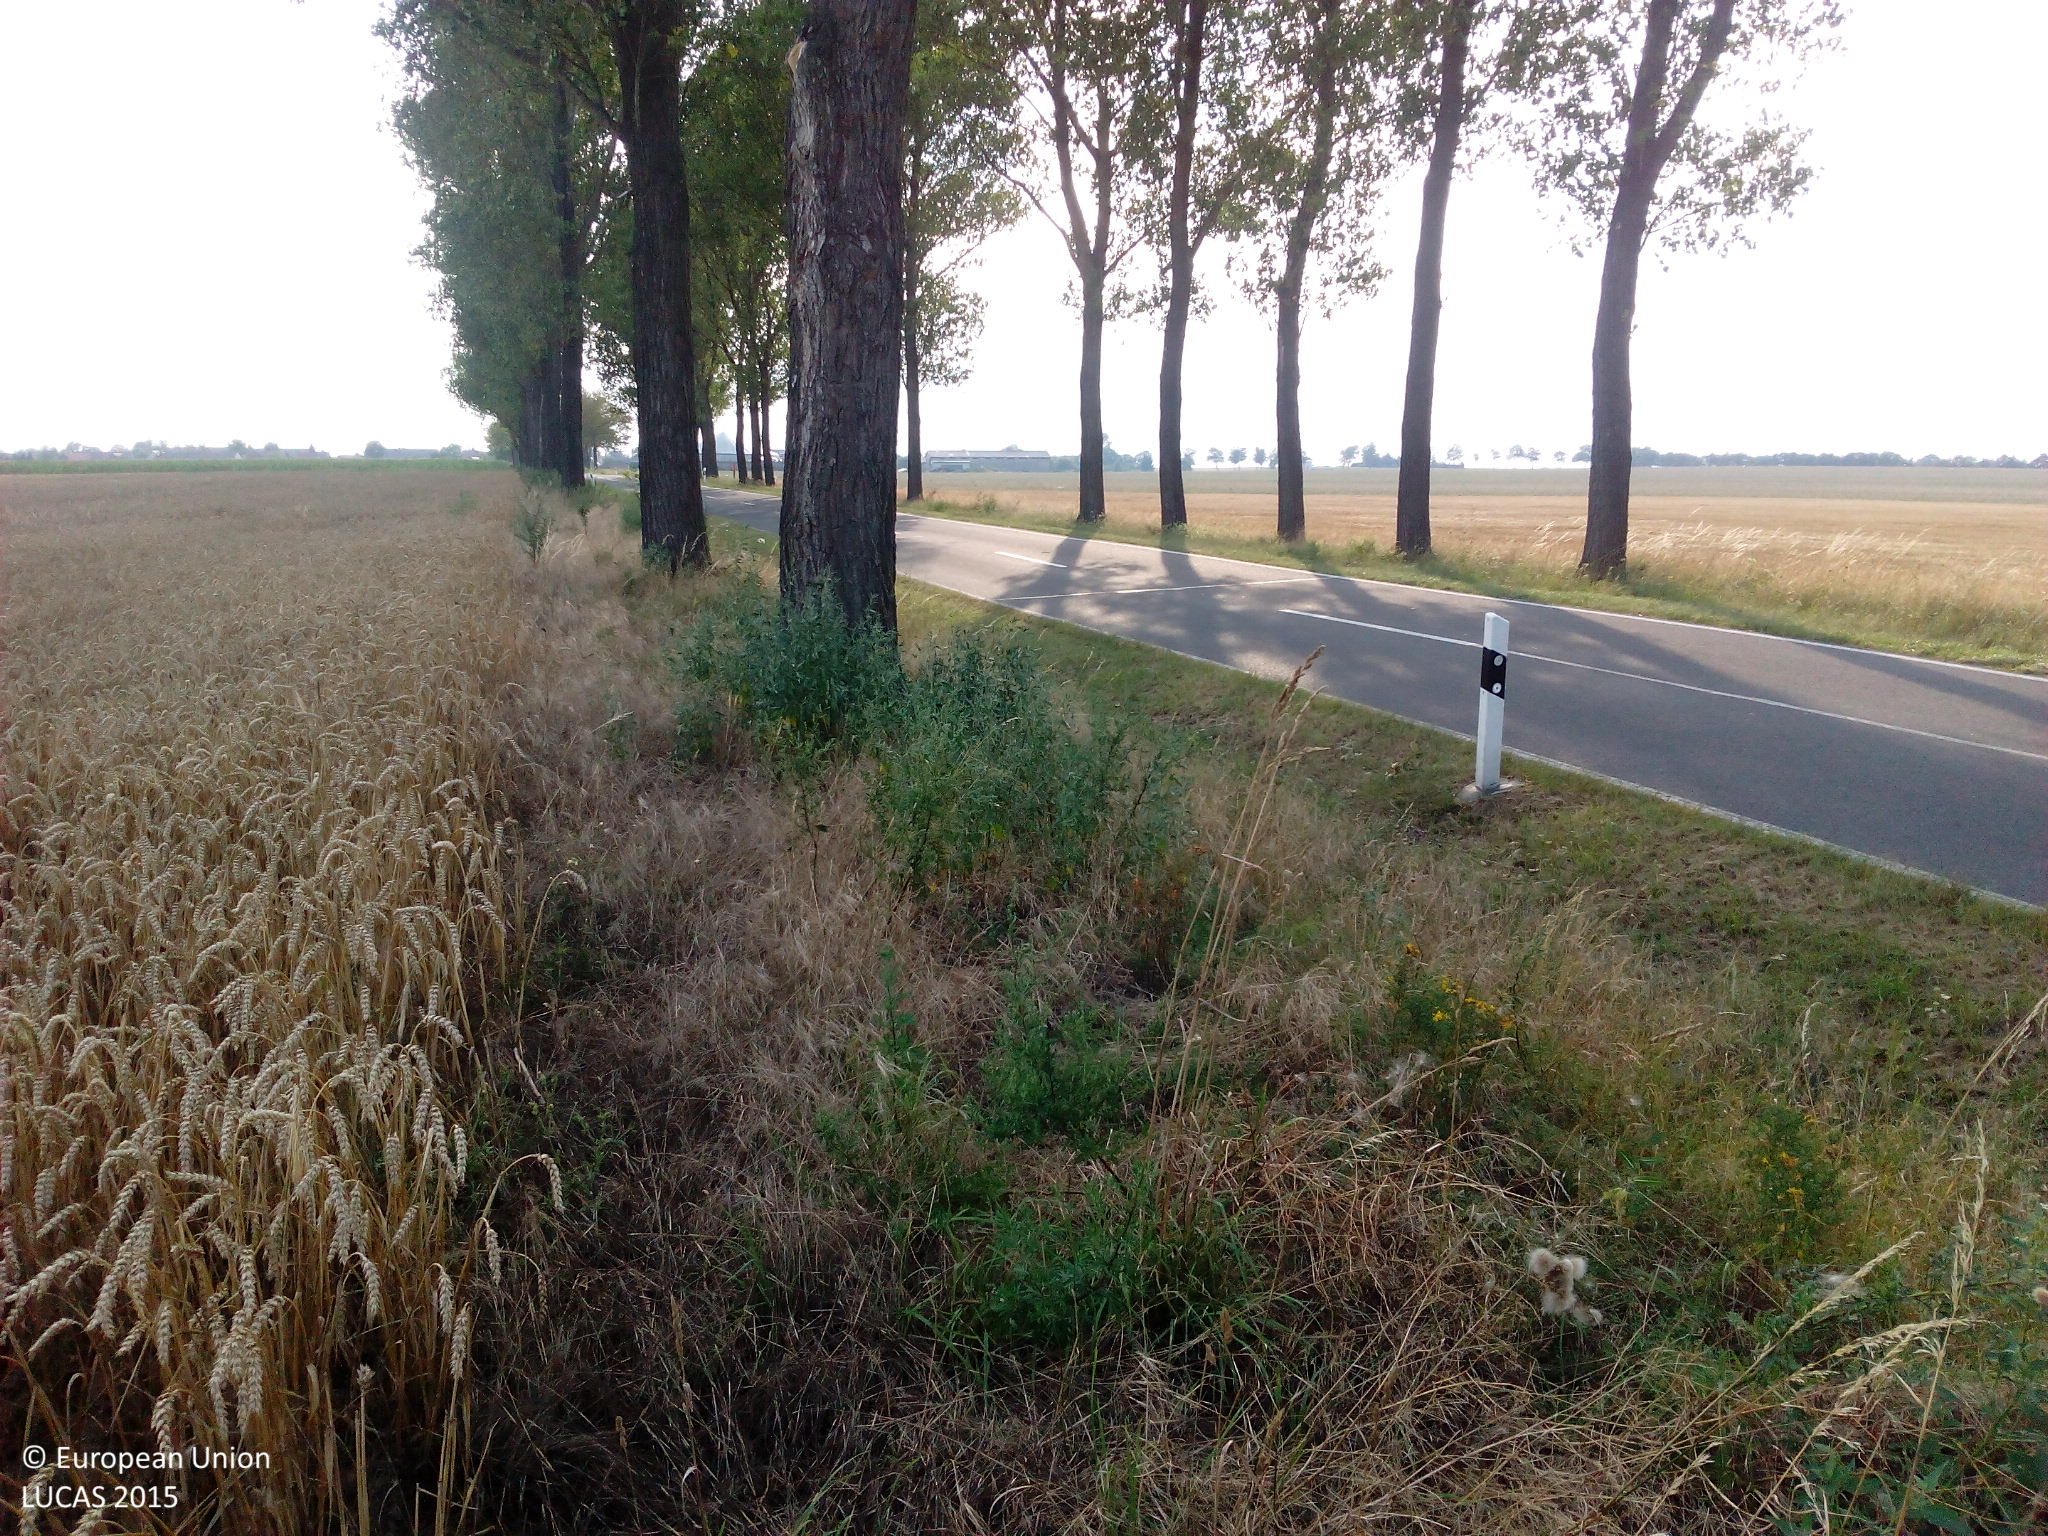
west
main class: Cropland
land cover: Common wheat
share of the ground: > 75 %
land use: Agriculture (excluding fallow land and kitchen gardens)
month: August
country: DE
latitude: 51.9039
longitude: 13.1541
